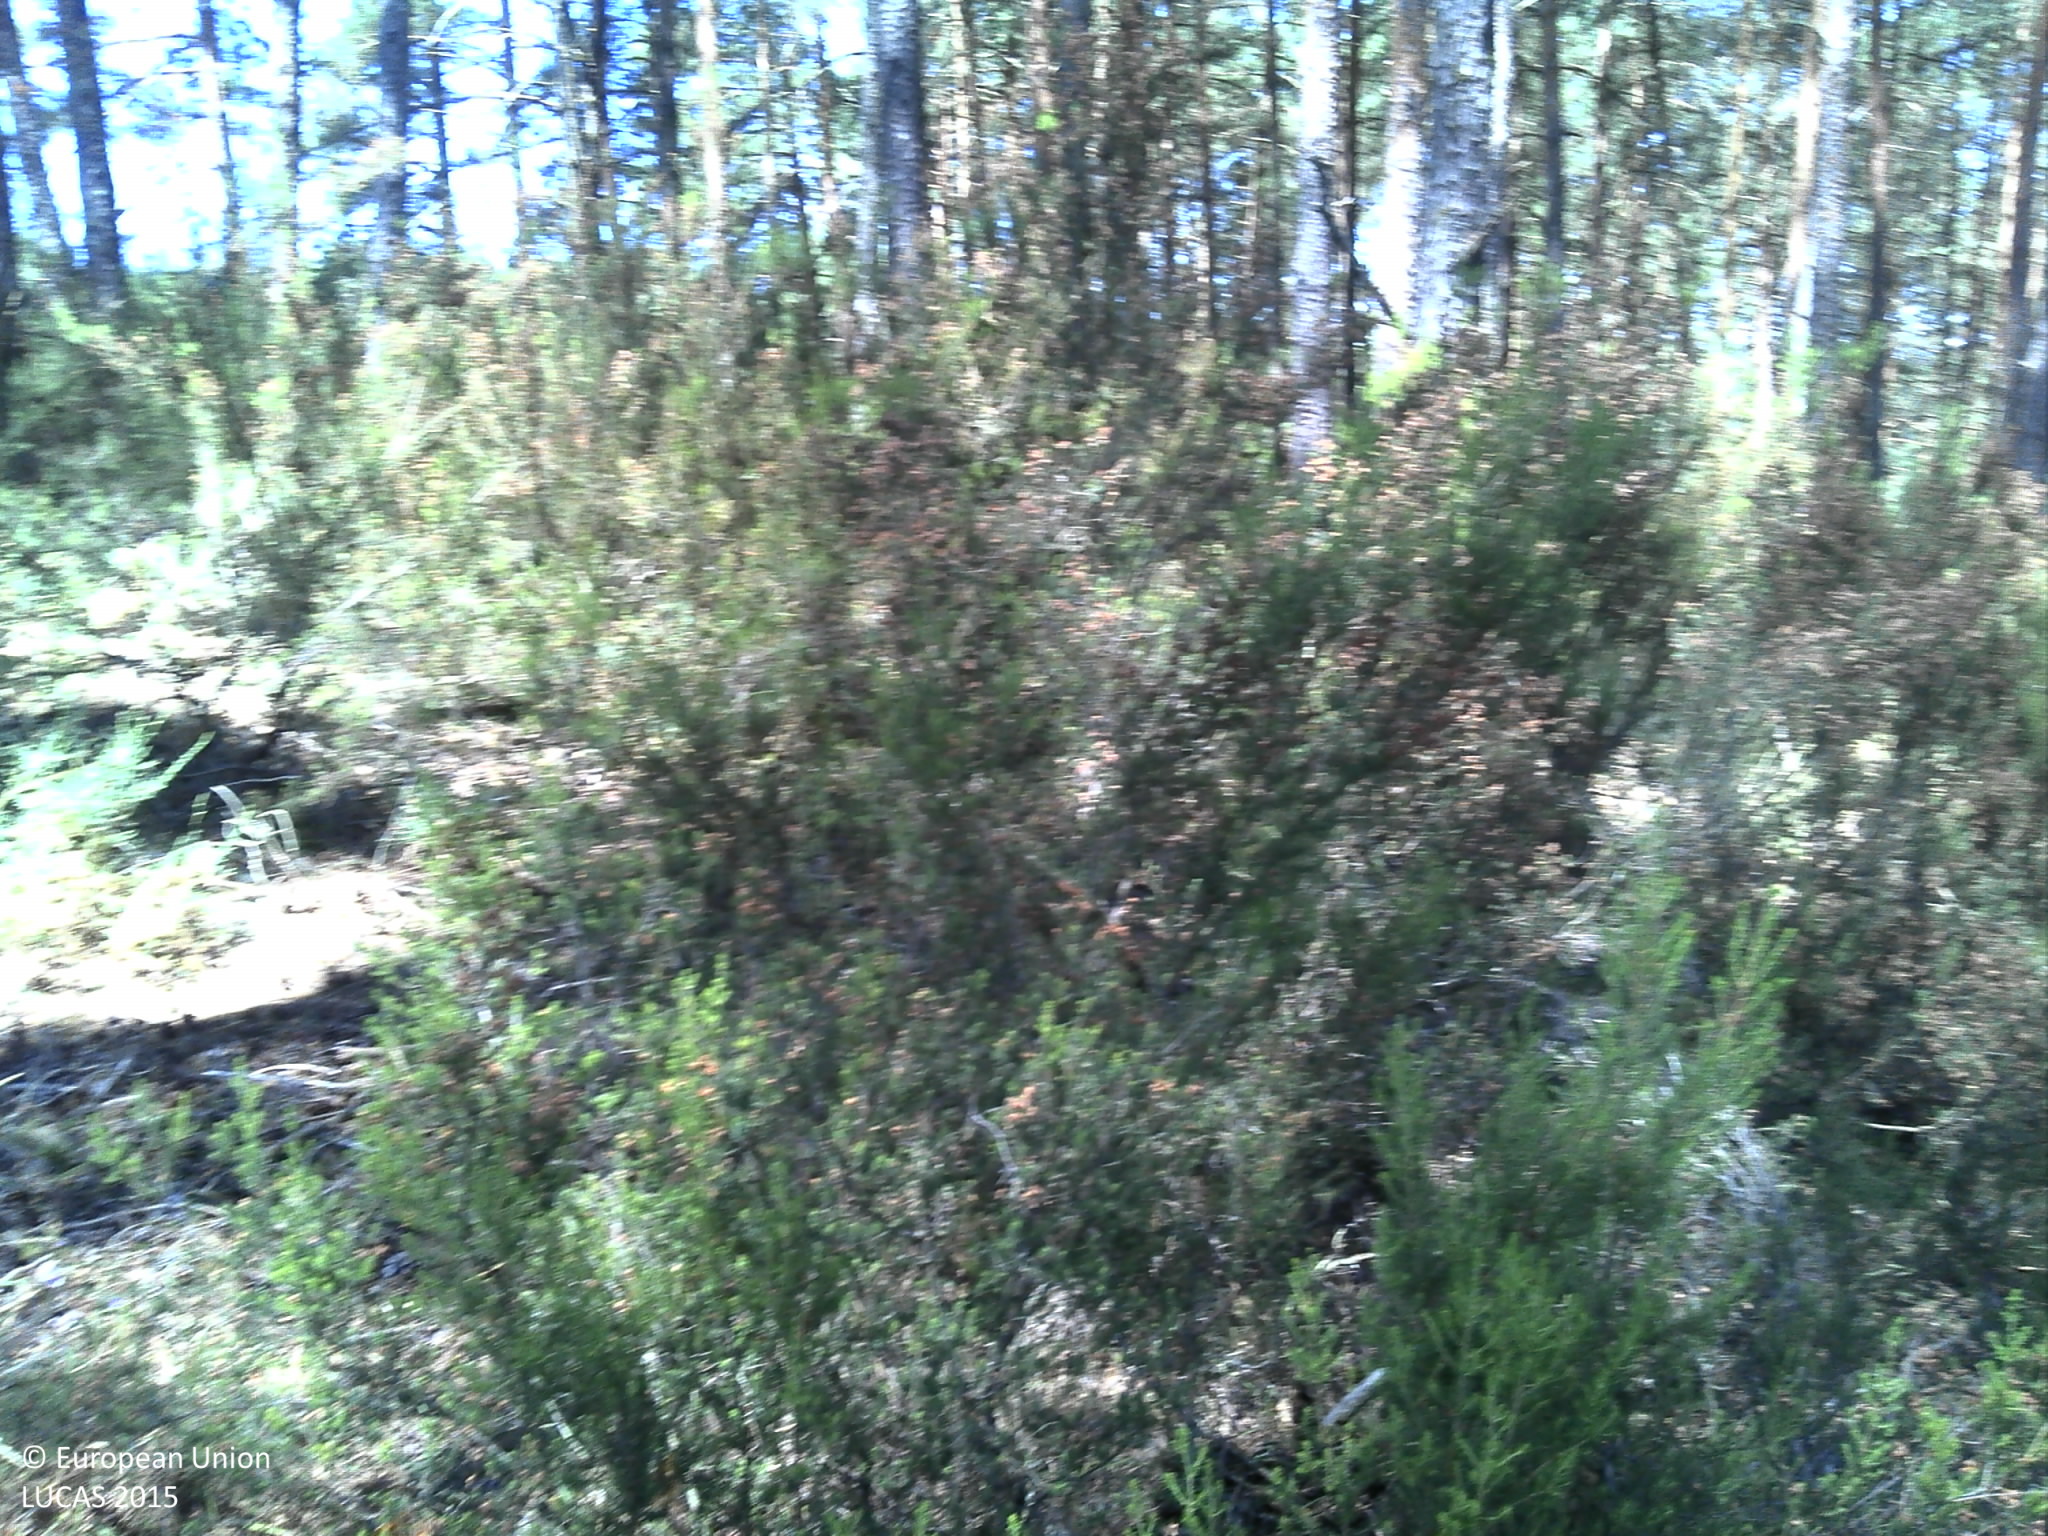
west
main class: Woodland
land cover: Pine dominated coniferous woodland
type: coniferous forest of the mediterranean region
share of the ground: > 75 %
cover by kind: coniferous forest trees 90 %, shrubs 5 %, unconsolidated bare surface 5 %
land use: Forestry
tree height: > 5 m
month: July
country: PT
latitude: 41.4949
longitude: -7.7544
